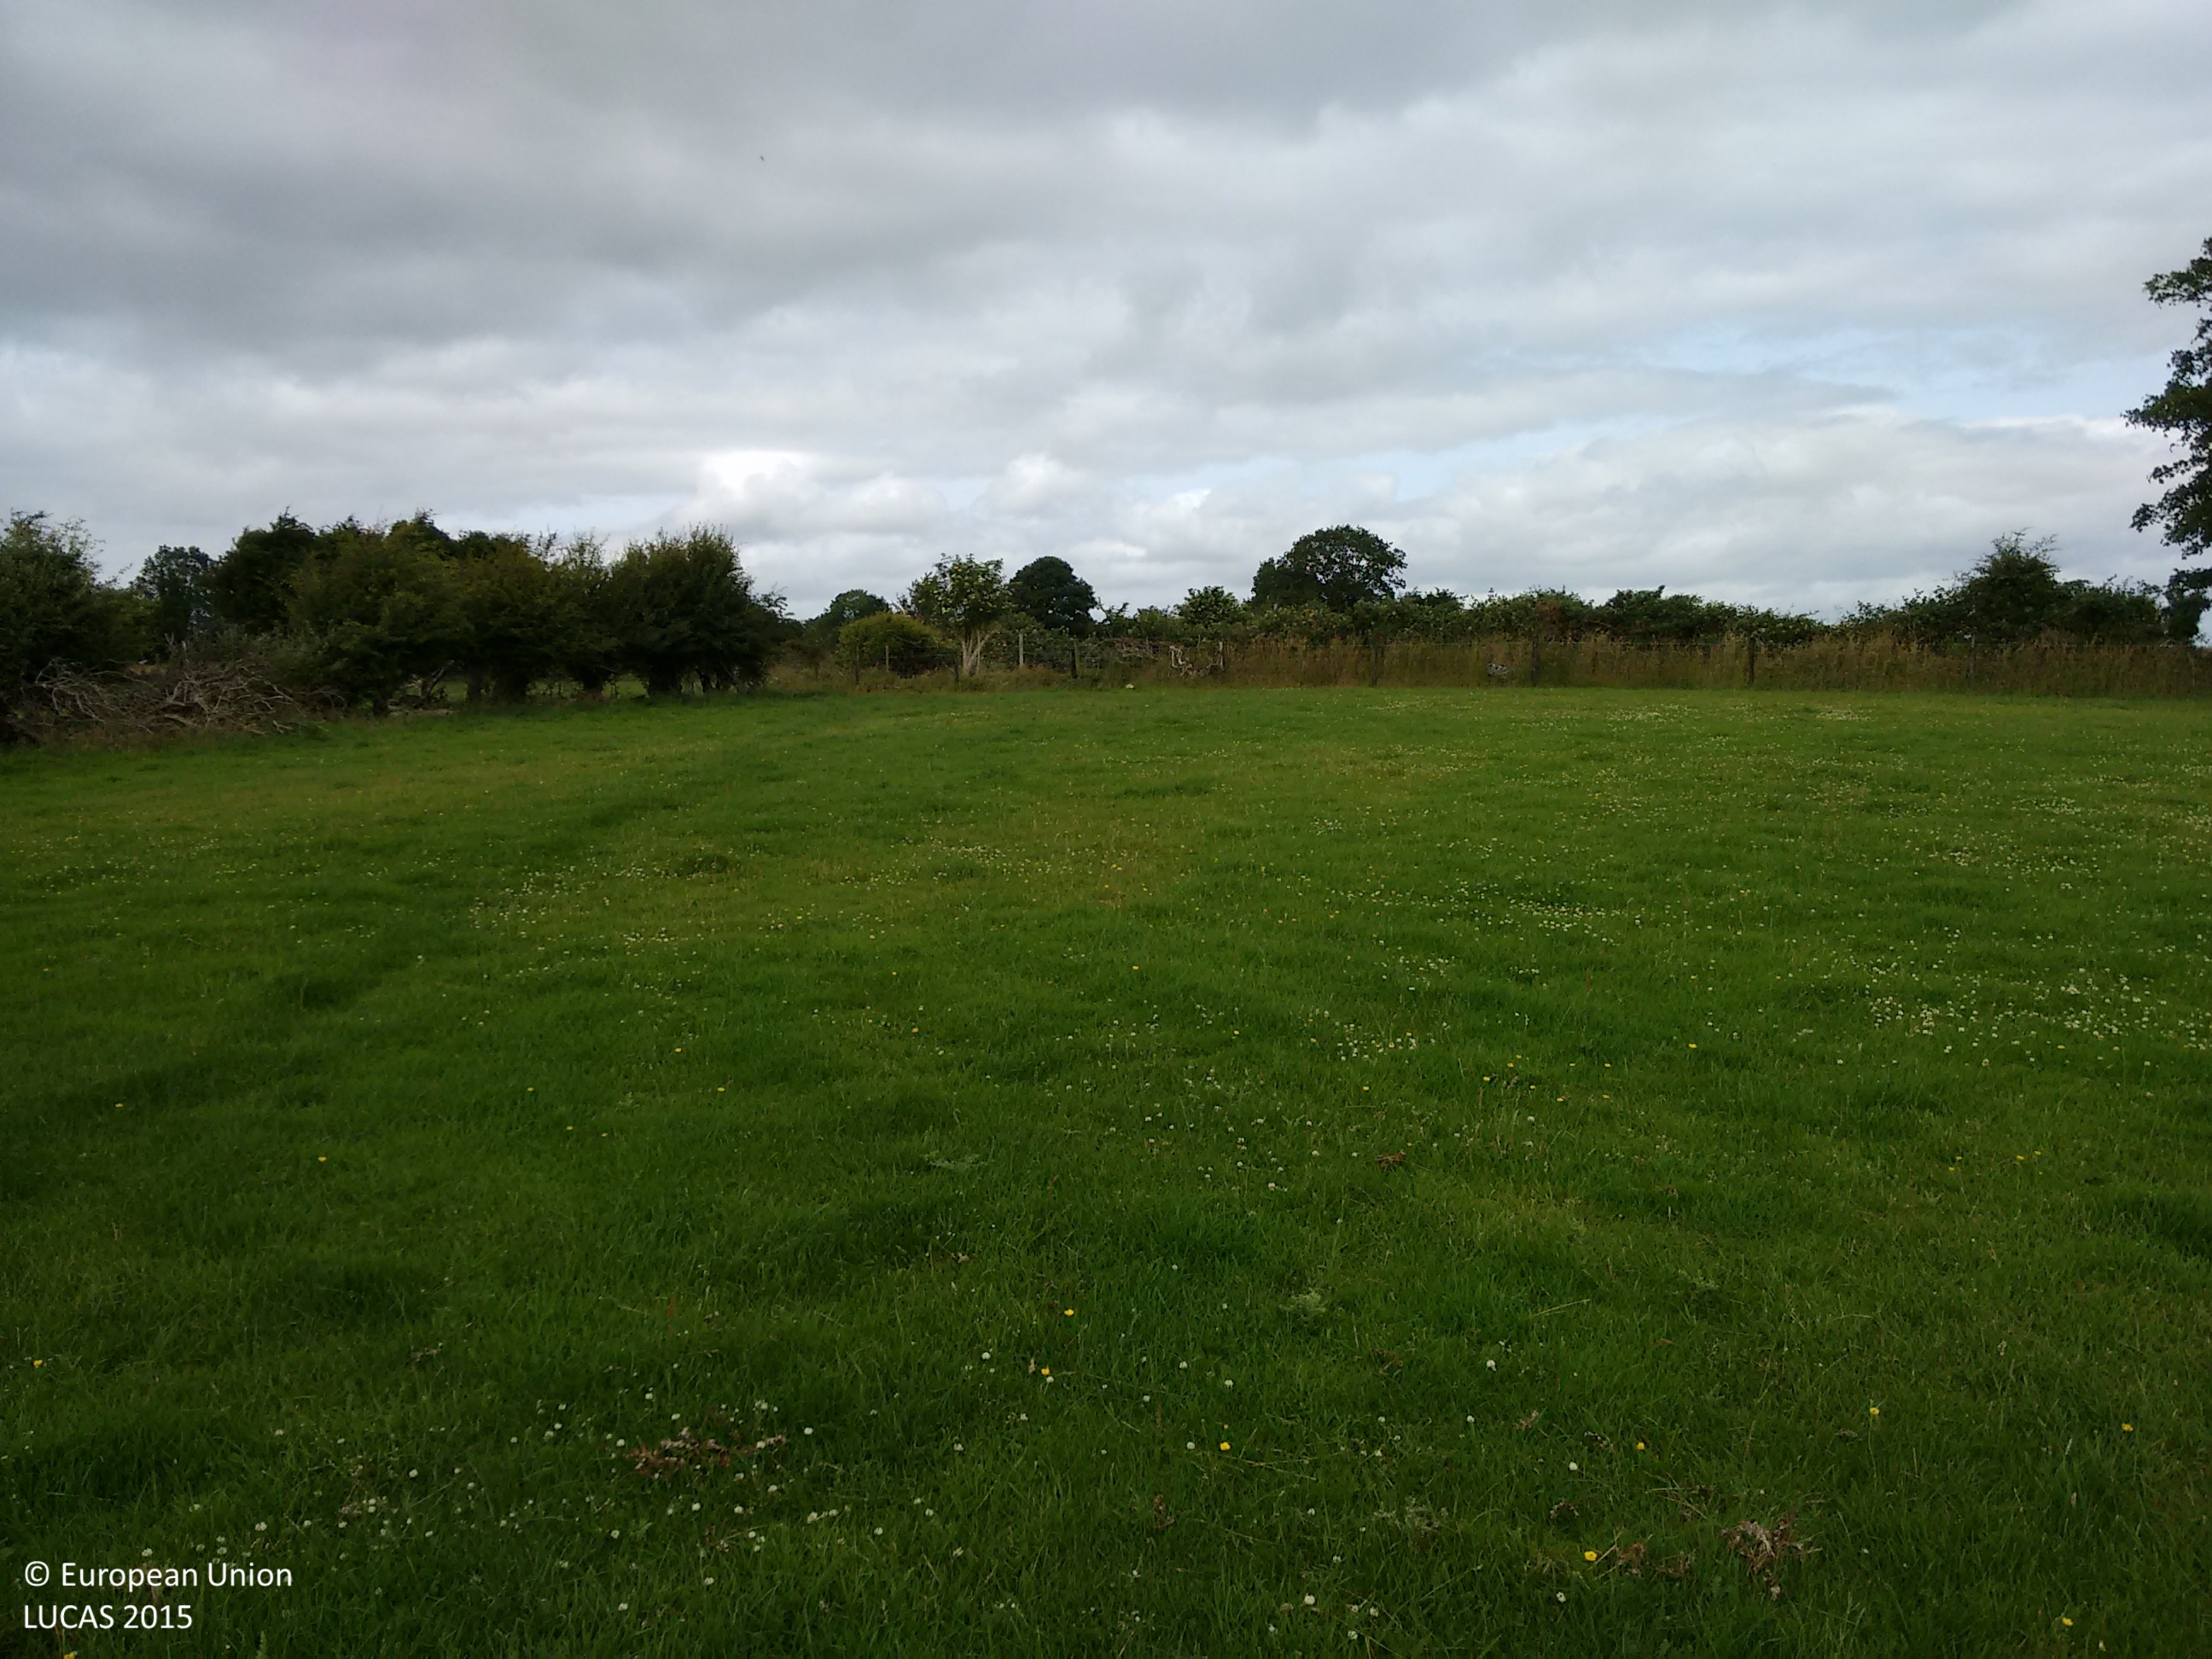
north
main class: Grassland
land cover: Grassland without tree/shrub cover
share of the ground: > 75 %
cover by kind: herbaceous plants 100 %
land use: Agriculture (excluding fallow land and kitchen gardens)
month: July
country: IE
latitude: 53.5062
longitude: -8.0437
